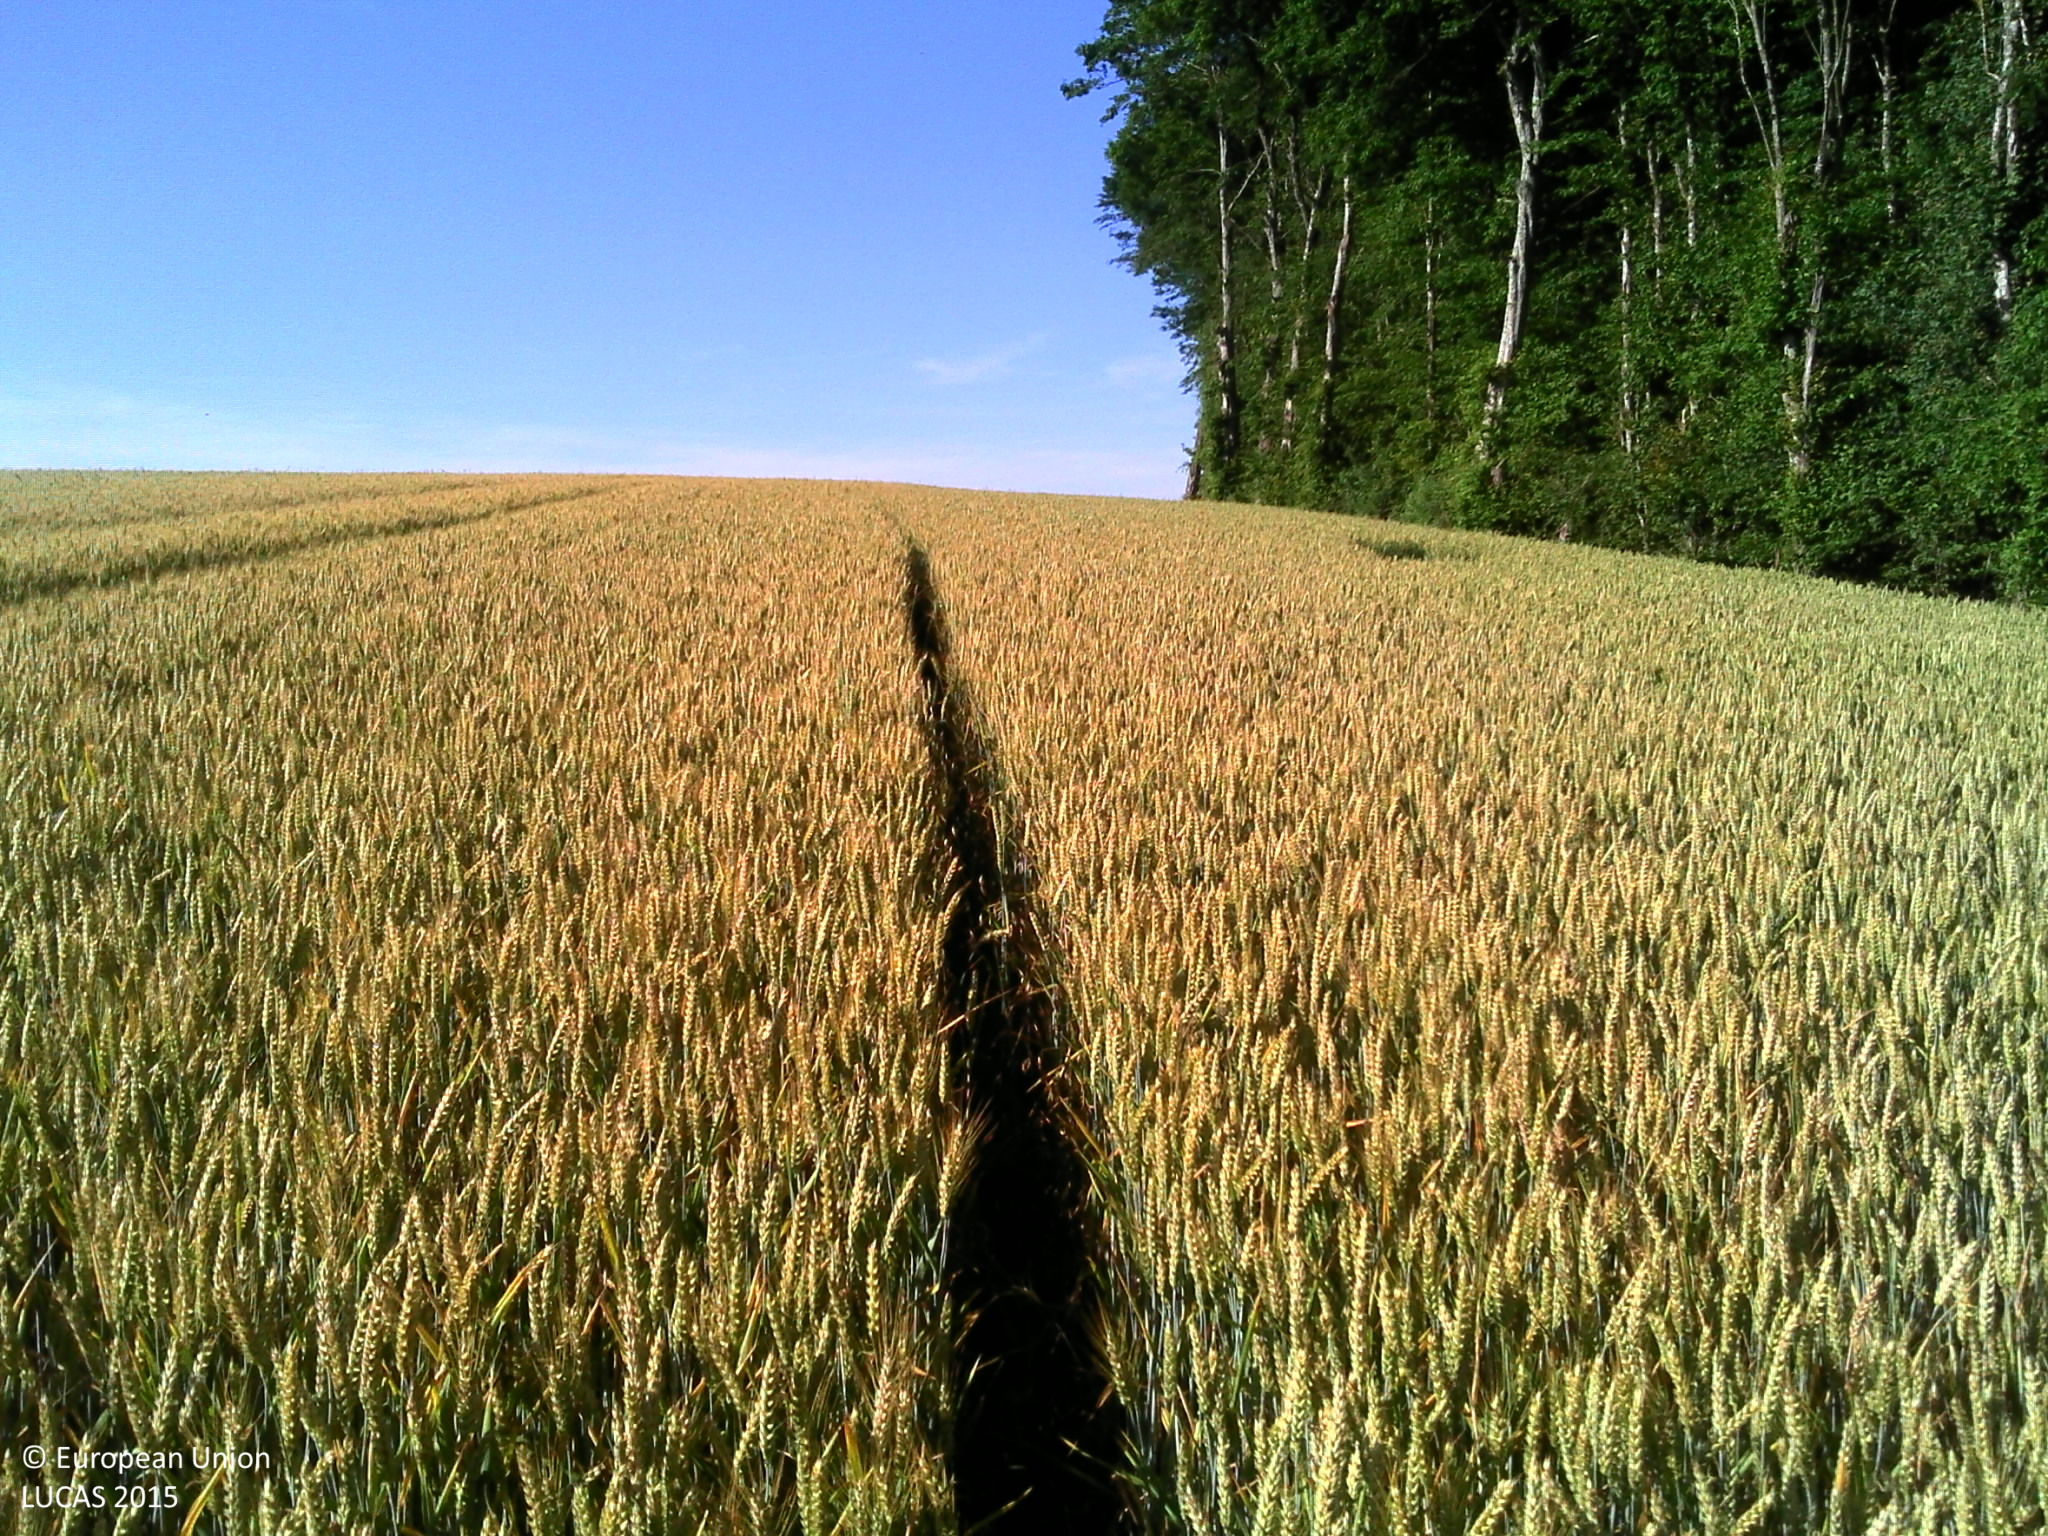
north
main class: Cropland
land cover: Common wheat
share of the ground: > 75 %
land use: Agriculture (excluding fallow land and kitchen gardens)
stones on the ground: 10 - 25 %
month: June
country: FR
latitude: 47.3992
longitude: 3.4907
